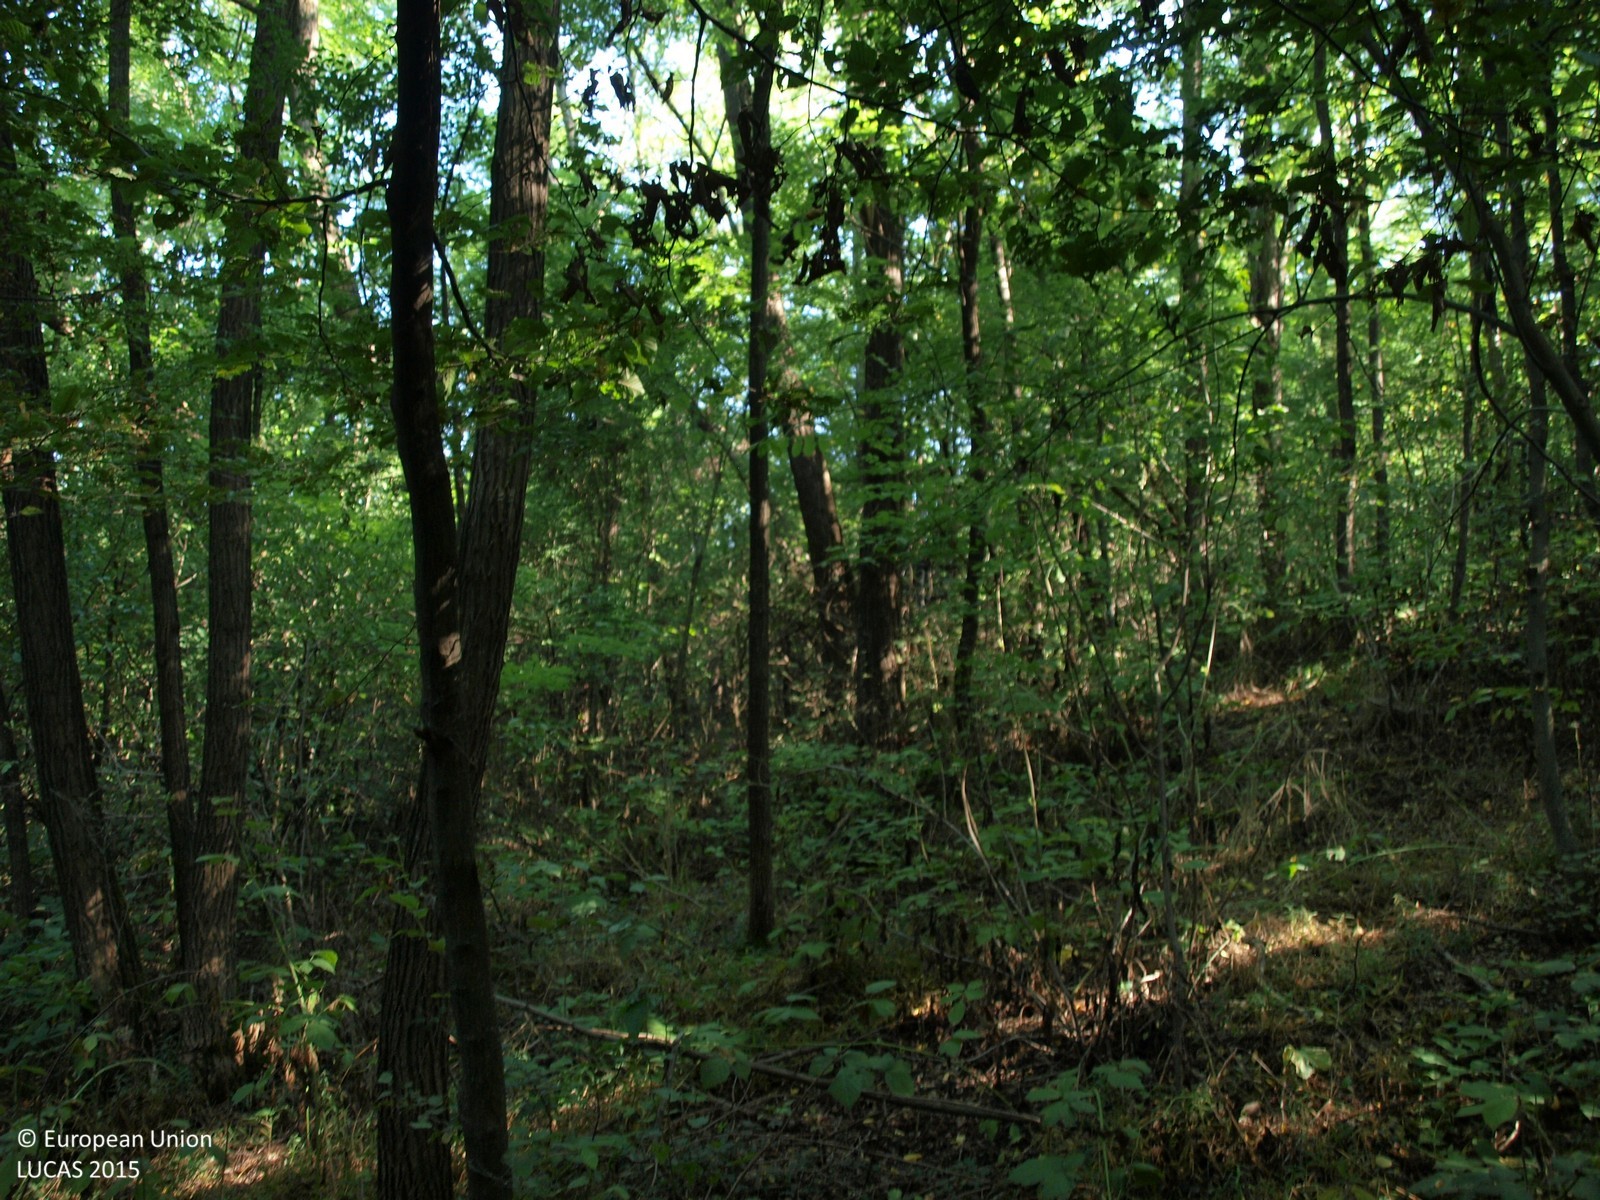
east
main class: Woodland
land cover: Broadleaved woodland
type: mesophytic deciduous forest
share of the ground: > 75 %
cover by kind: broadleaved forest trees 100 %
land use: Forestry
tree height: > 5 m
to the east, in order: Broadleaved woodland; Artificial constructions in urban areas; Lucerne; Vineyards; Grassland without tree/shrub cover; Vineyards; Grassland without tree/shrub cover; Vineyards; Apple fruit; Vineyards; Other fruit trees and berries; Broadleaved woodland
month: August
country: HR
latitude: 46.0856
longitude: 16.4272
